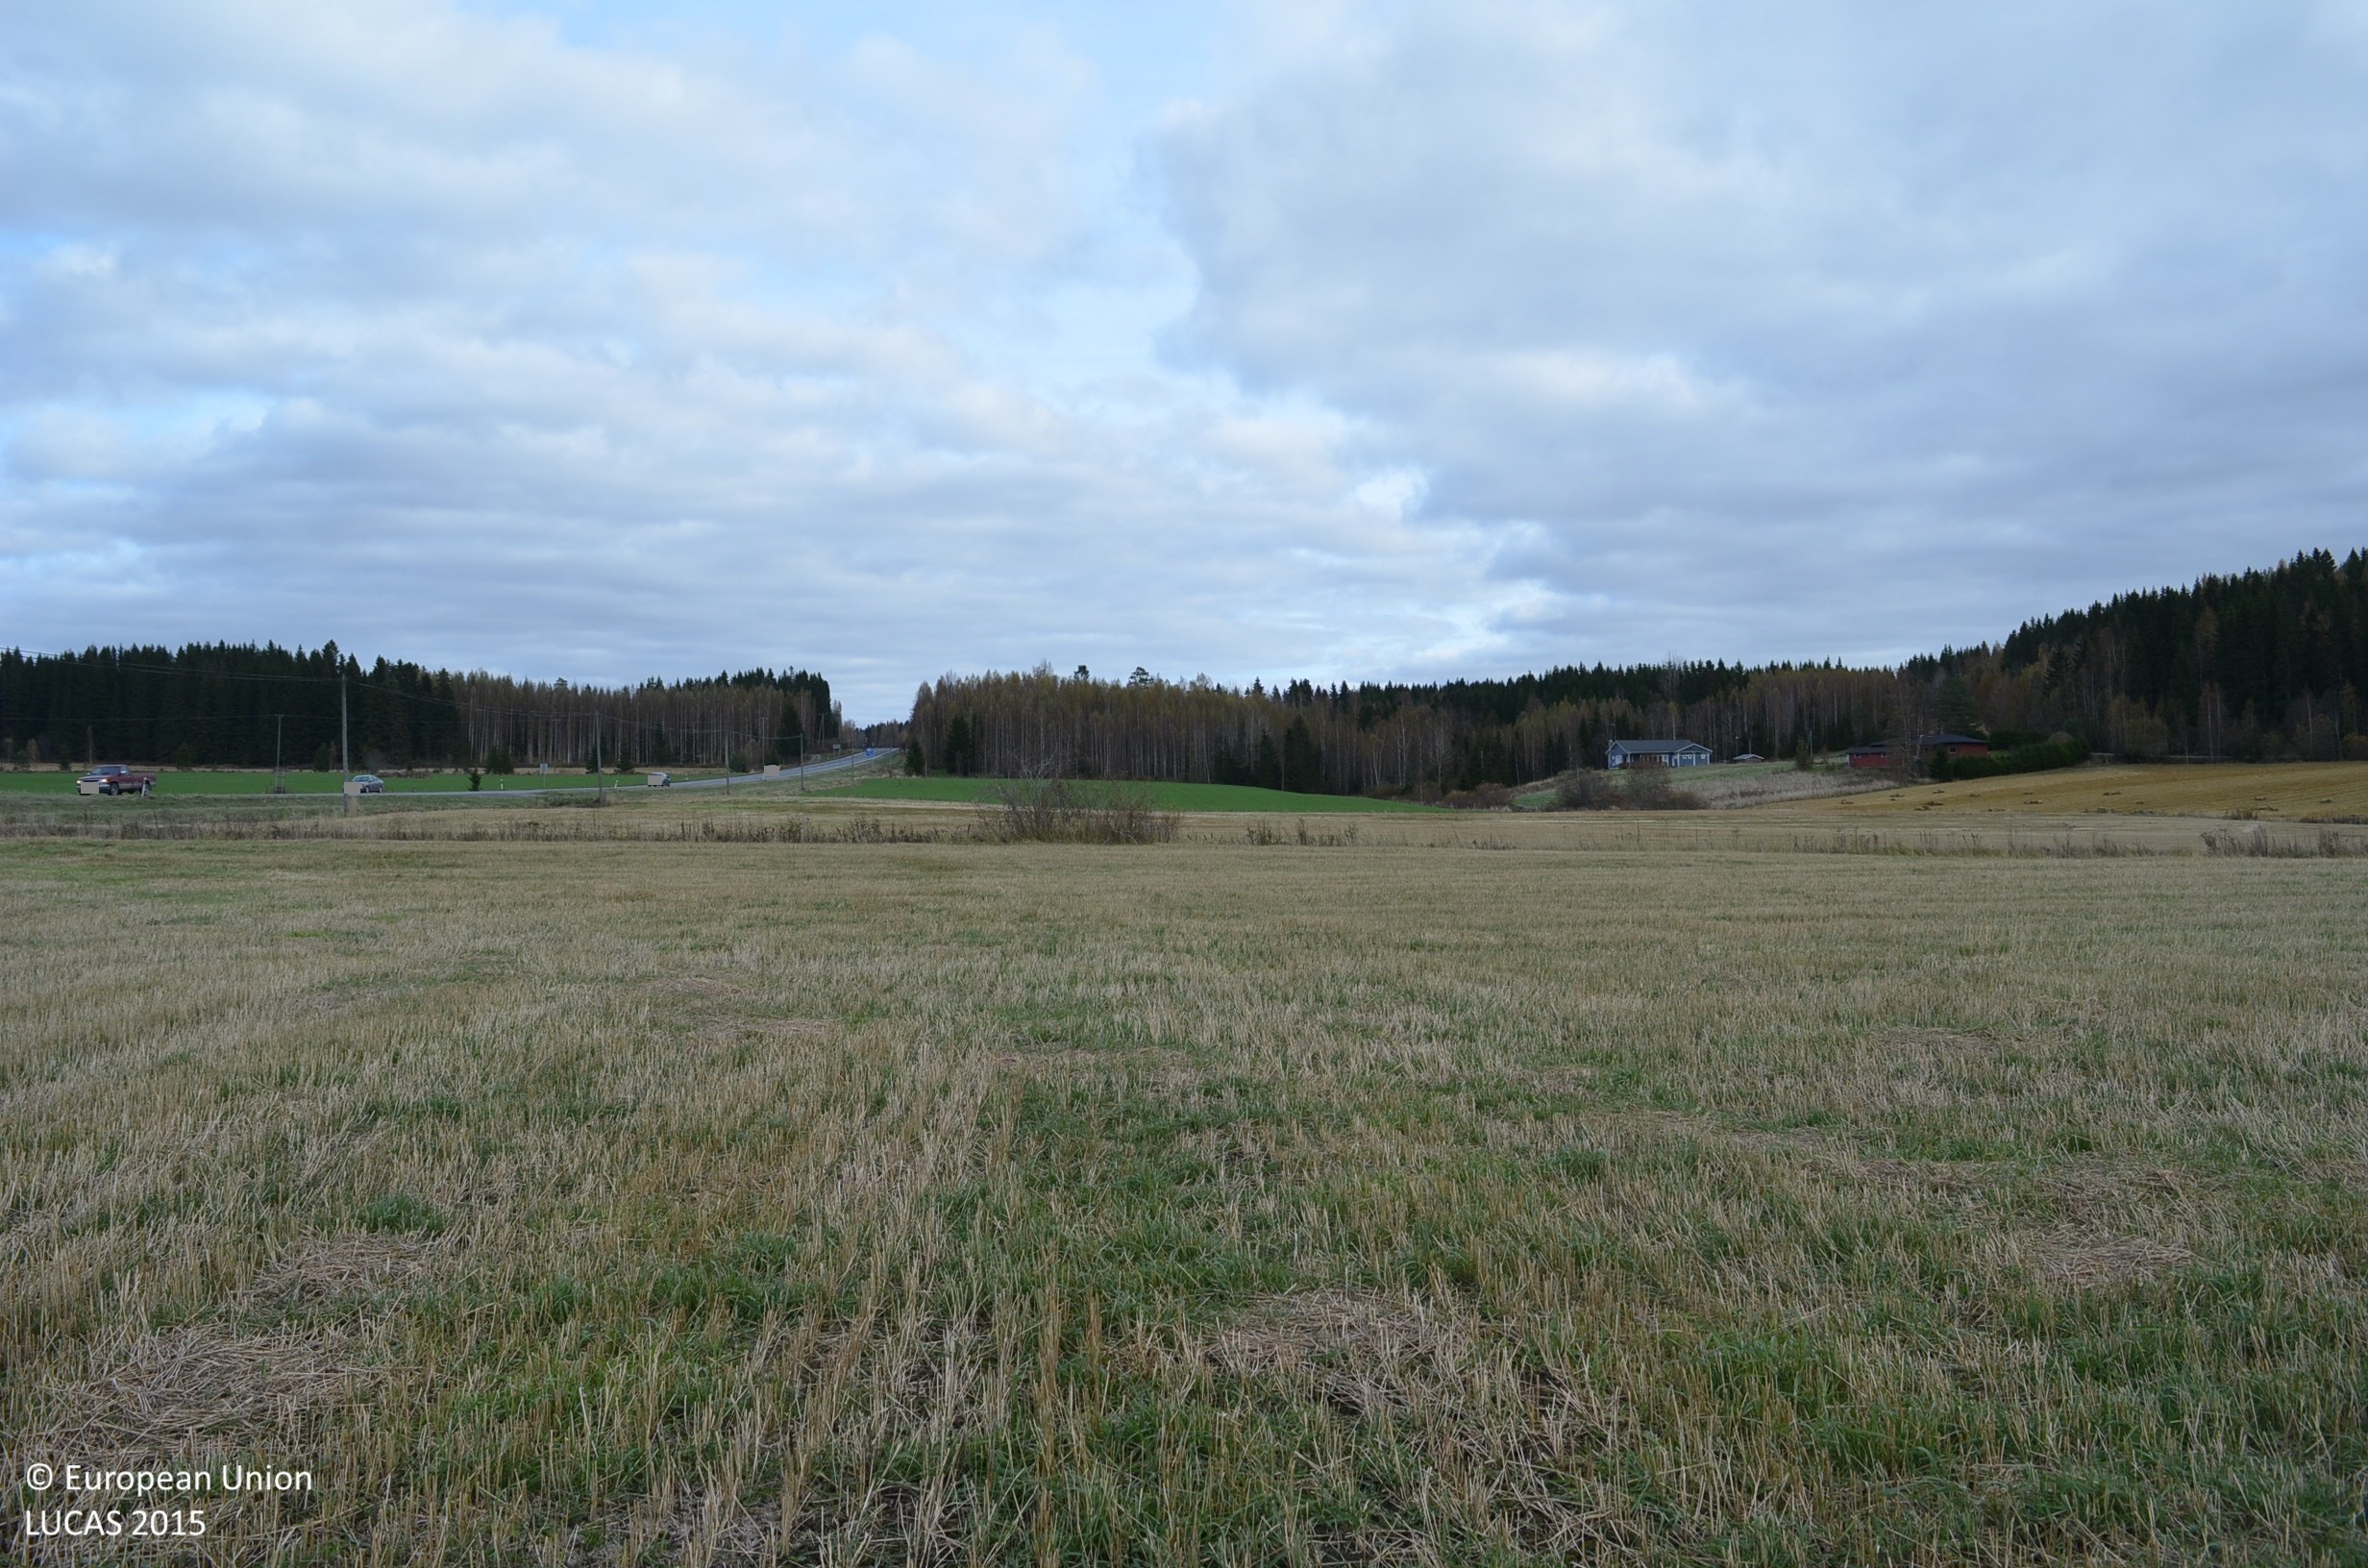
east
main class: Cropland
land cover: Barley
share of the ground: > 75 %
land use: Agriculture (excluding fallow land and kitchen gardens)
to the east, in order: Barley; Grass margins; Ditches and canals; Grass margins; Oats; Tracks; Grass margins; Ditches and canals; Grass margins; Rye; Barley
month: October
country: FI
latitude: 61.4996
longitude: 23.1679
